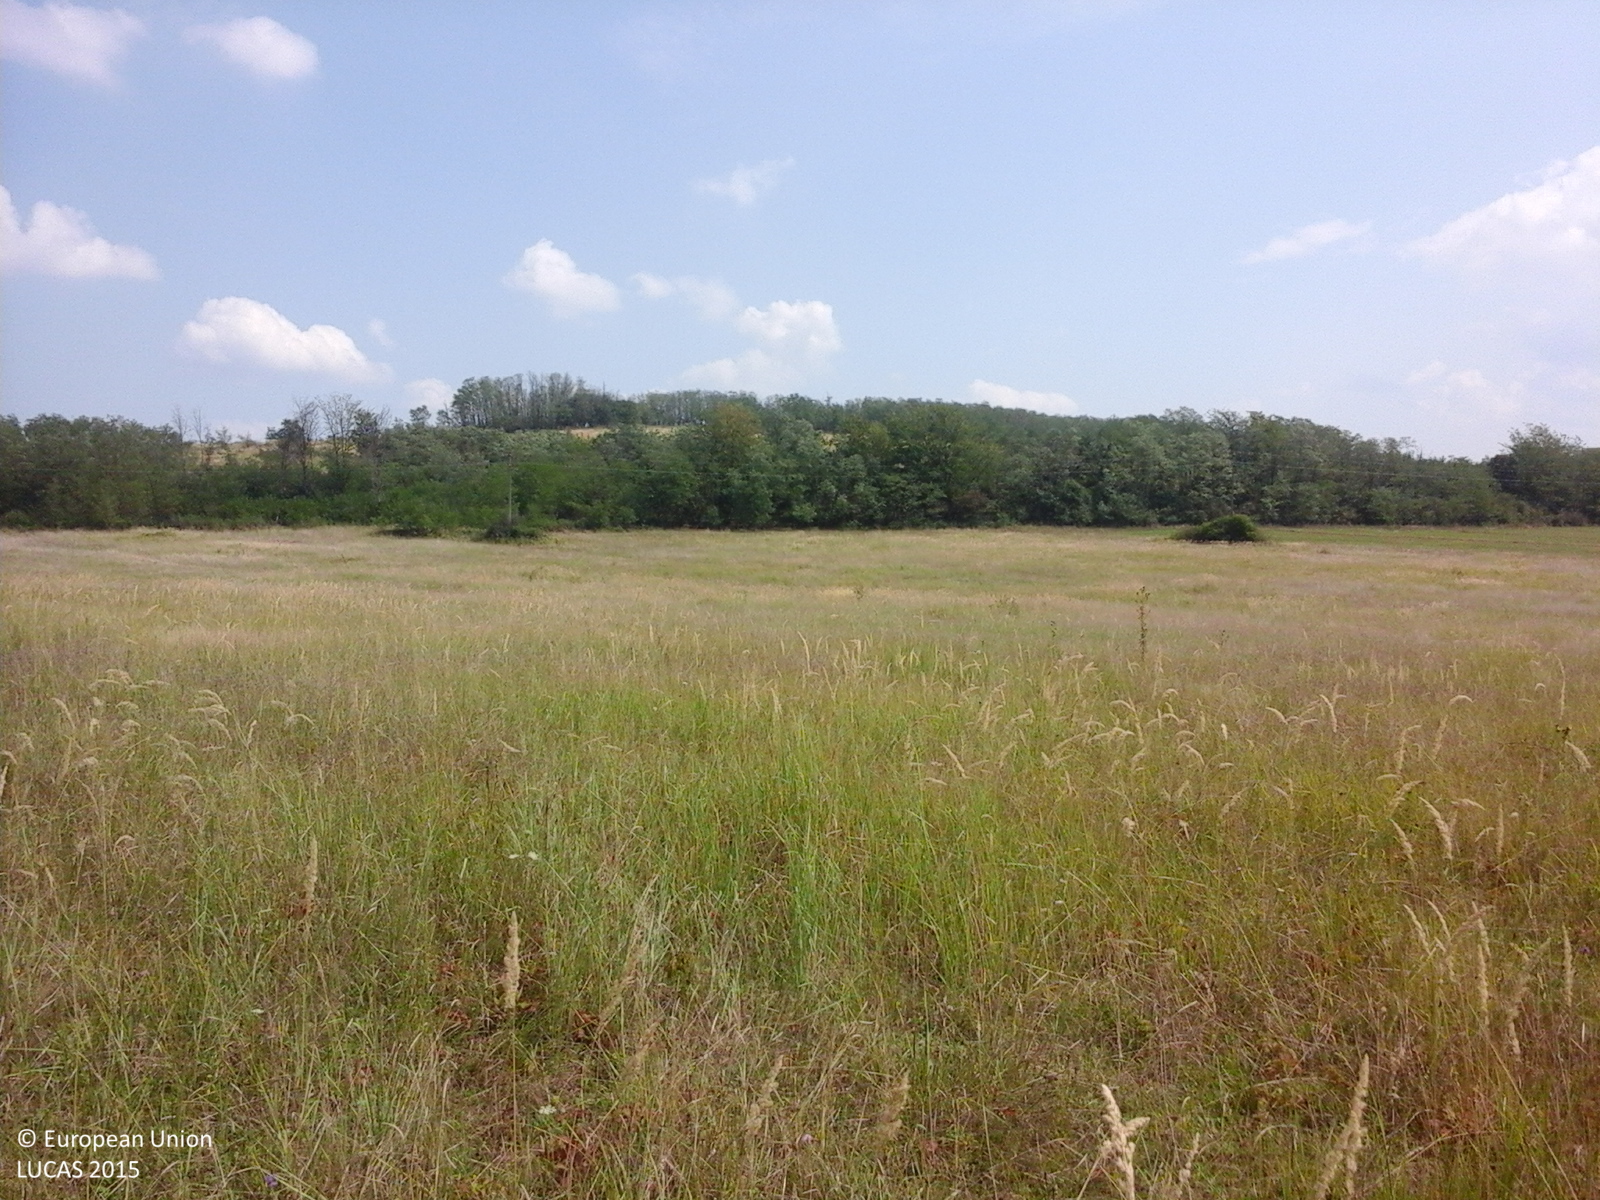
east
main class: Grassland
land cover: Grassland without tree/shrub cover
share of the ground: > 75 %
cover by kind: herbaceous plants 100 %
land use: Agriculture (excluding fallow land and kitchen gardens)
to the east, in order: Grassland without tree/shrub cover; Spontaneously vegetated surfaces; Electric lines; Shrubland without tree cover; Grassland without tree/shrub cover; Broadleaved woodland
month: August
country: RO
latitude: 46.3361
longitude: 21.9295
